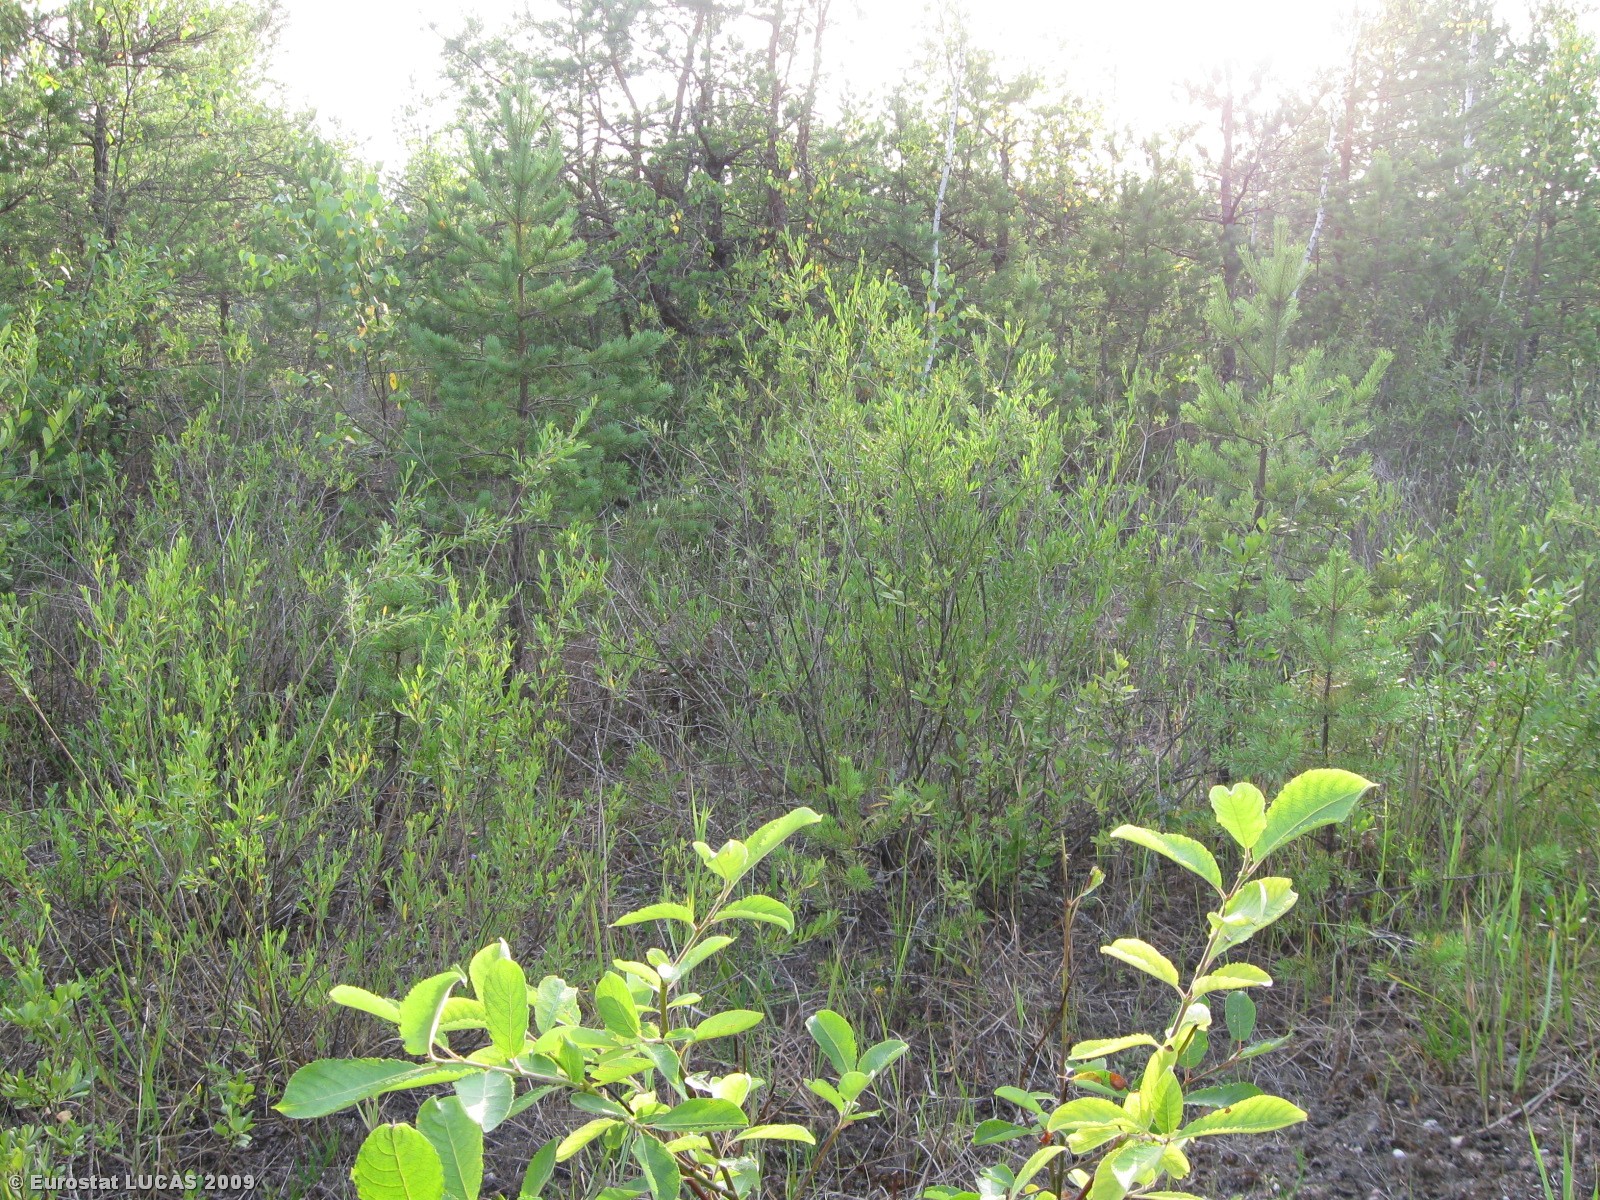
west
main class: Woodland
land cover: Mixed woodland
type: hemiboreal forest and nemoral coniferous forest and mixed broadleaved-coniferous forest
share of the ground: > 75 %
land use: Forestry
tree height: > 5 m
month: August
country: LT
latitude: 55.0853
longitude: 22.6447
